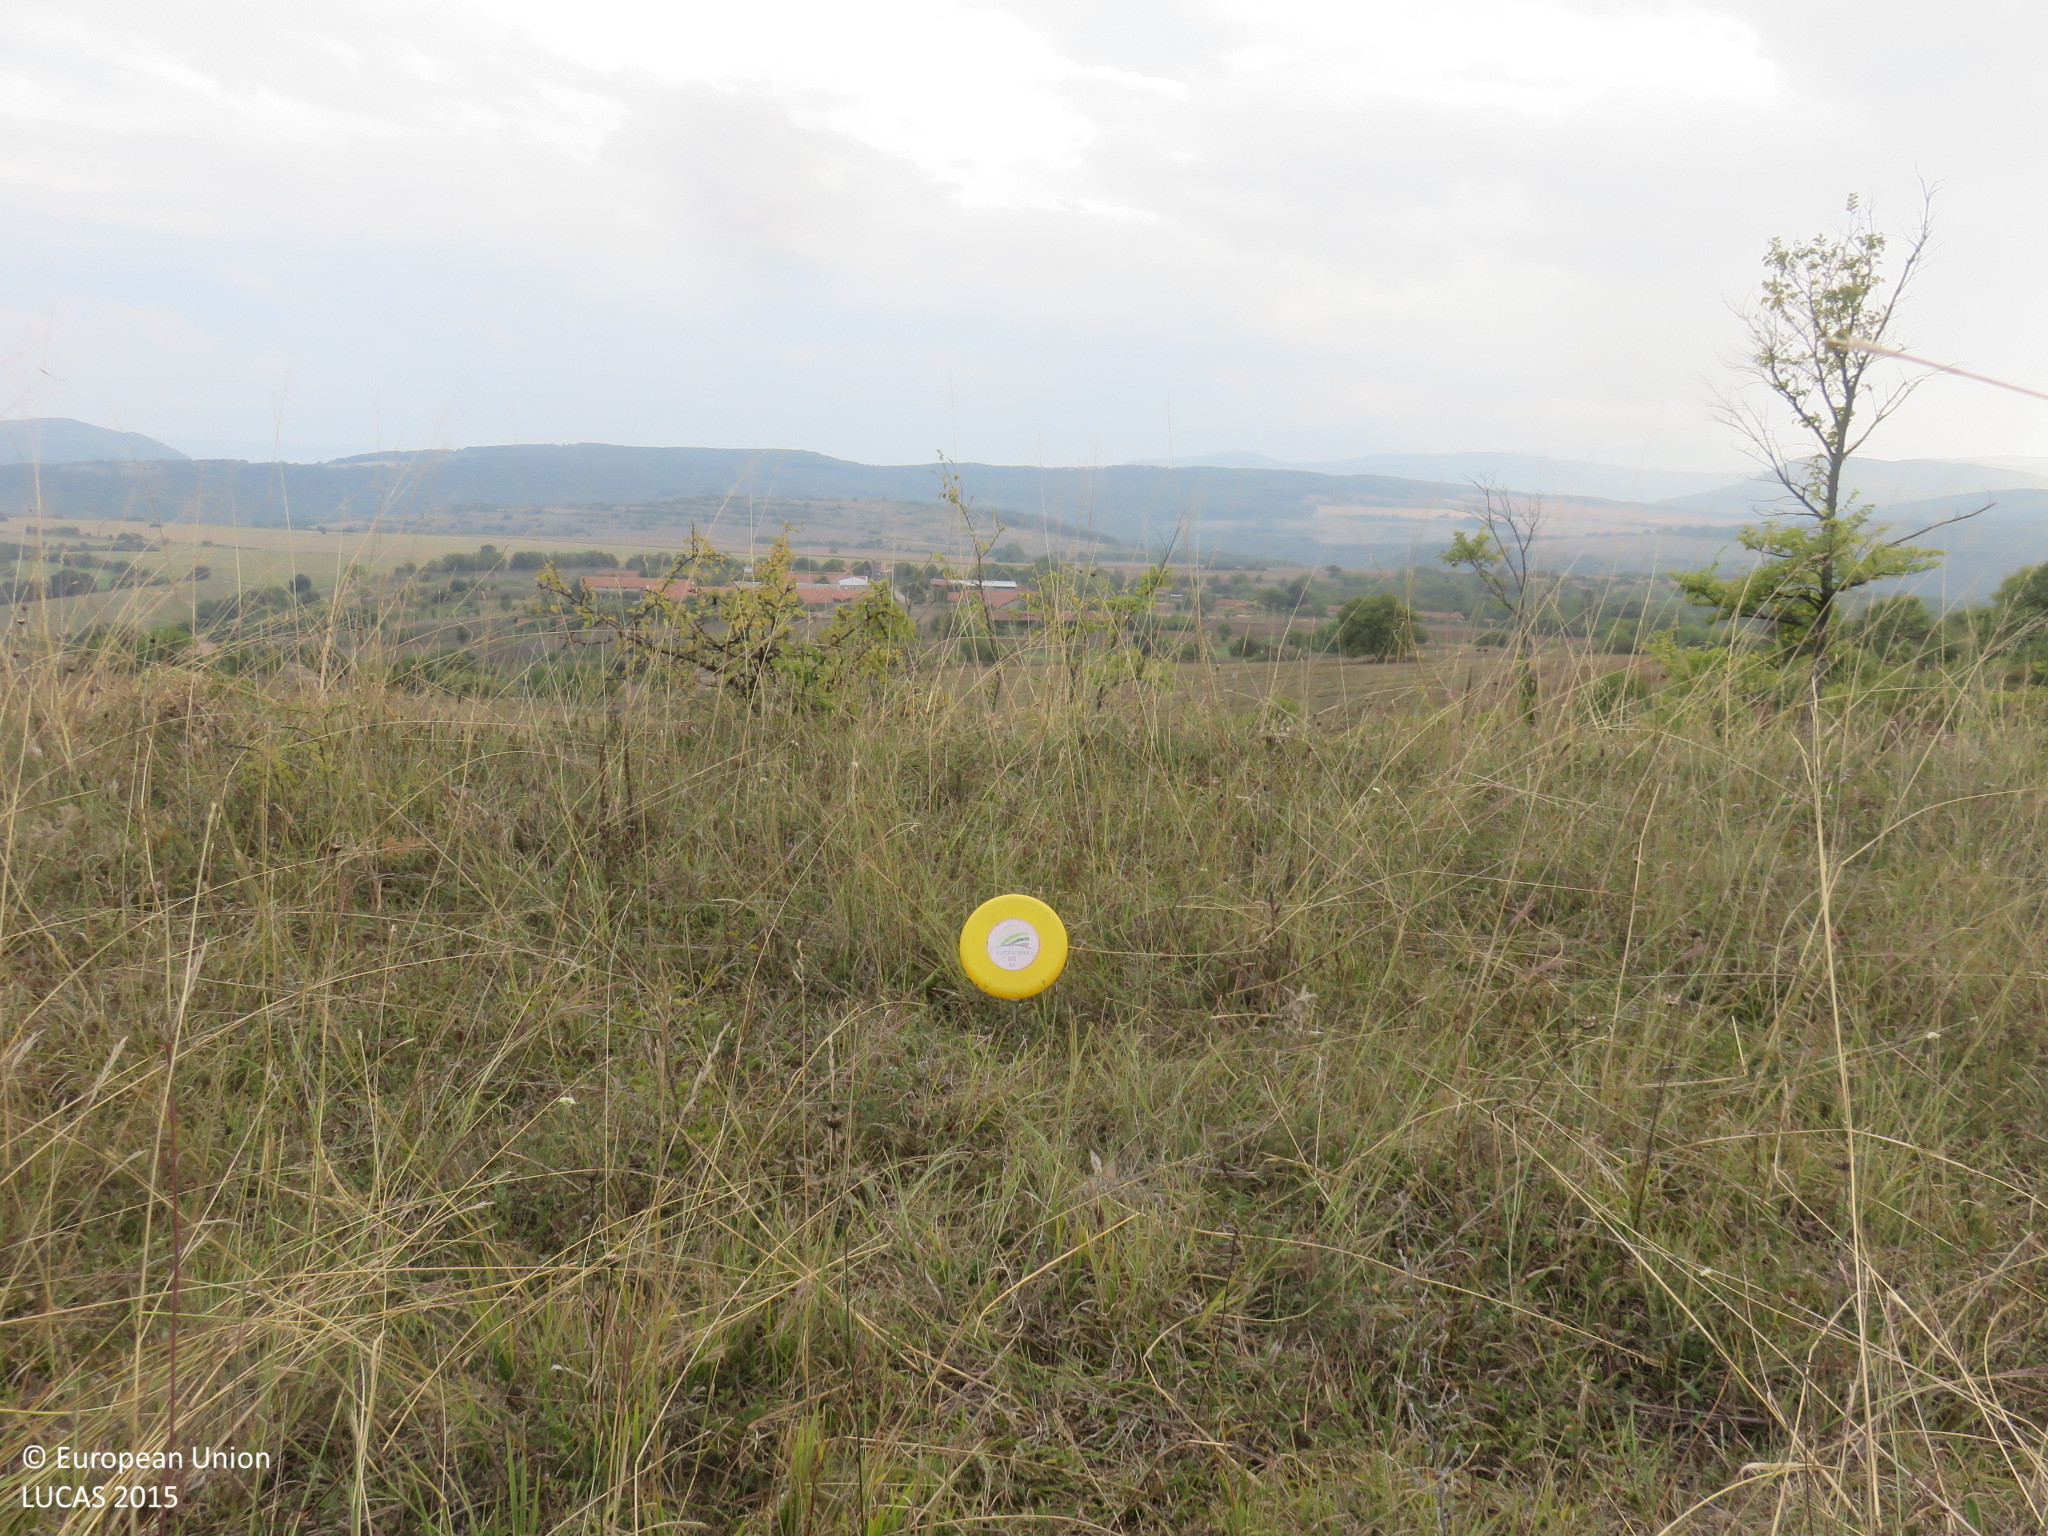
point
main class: Grassland
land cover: Grassland with sparse tree/shrub cover
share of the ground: > 75 %
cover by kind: herbaceous plants 90 %, broadleaved forest trees 5 %, shrubs 5 %
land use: Semi-natural and natural areas not in use
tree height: < 5 m
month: September
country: BG
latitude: 43.1032
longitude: 25.0210
